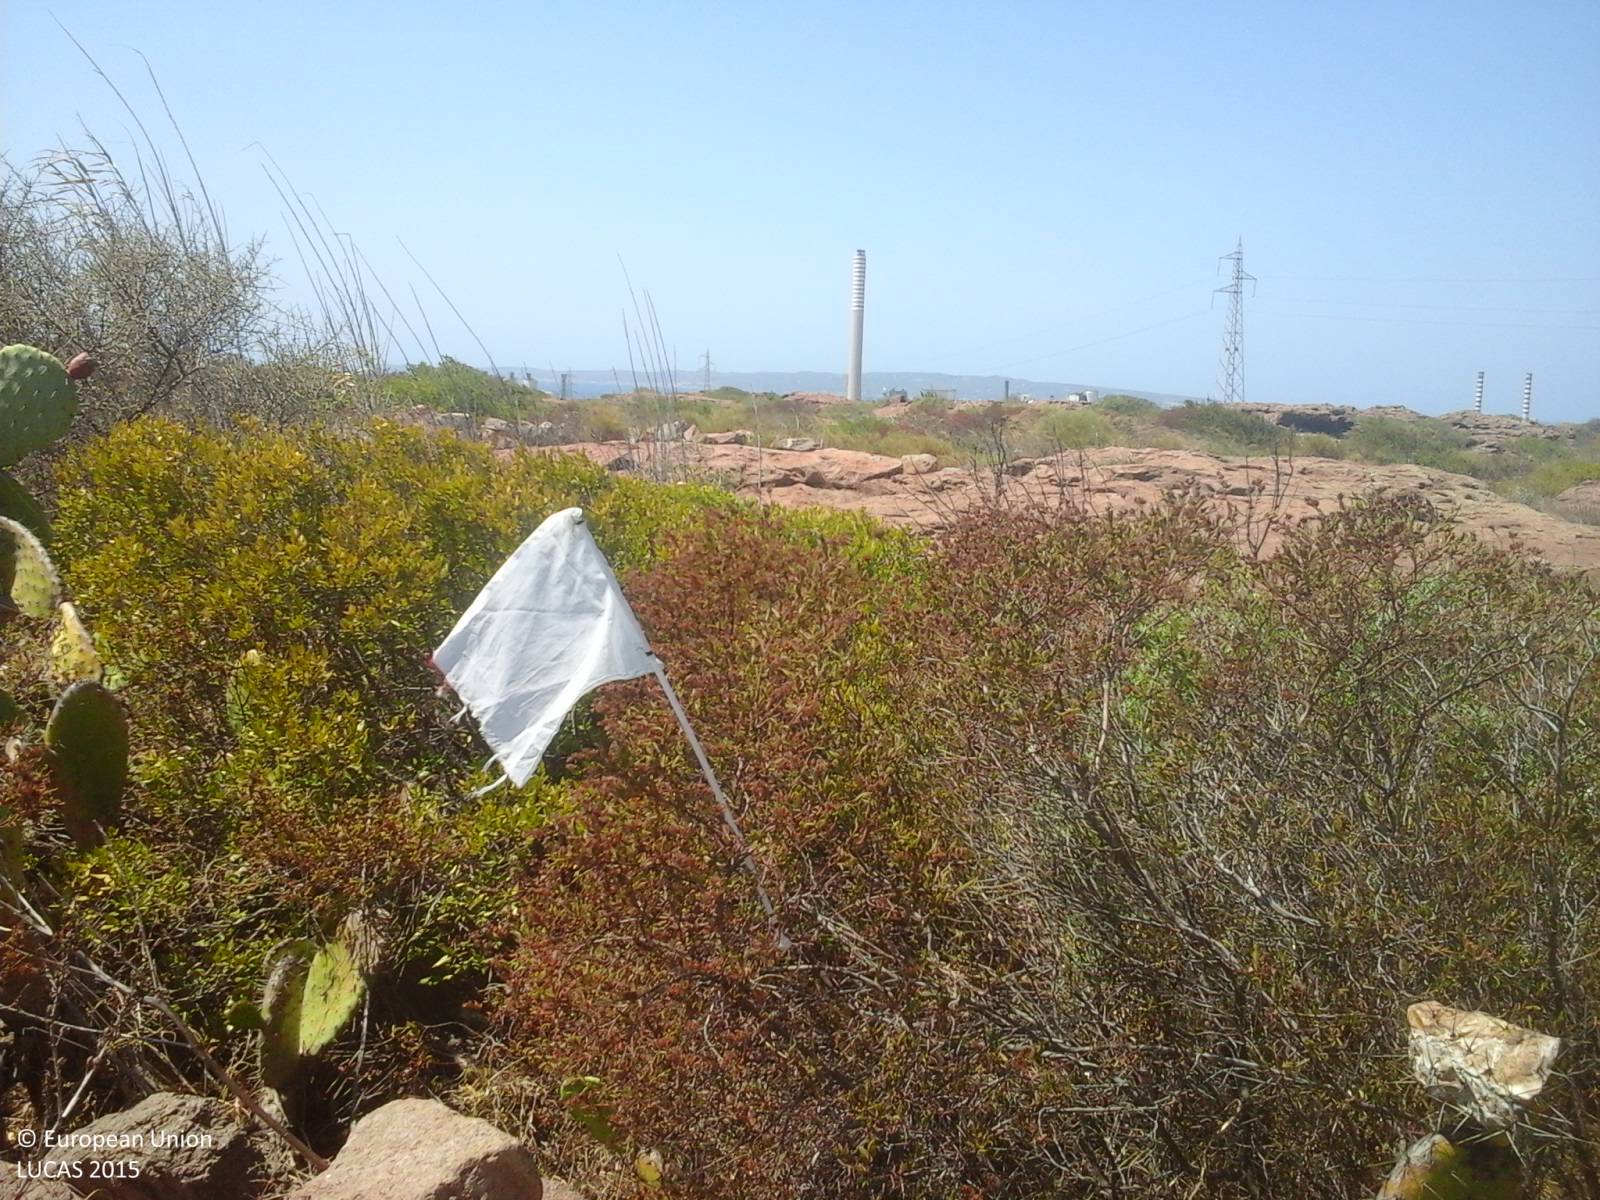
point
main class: Shrubland
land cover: Shrubland without tree cover
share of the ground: > 75 %
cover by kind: shrubs 60 %, herbaceous plants 20 %, unconsolidated bare surface 20 %
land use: Semi-natural and natural areas not in use
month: July
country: IT
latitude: 39.2040
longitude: 8.4233
